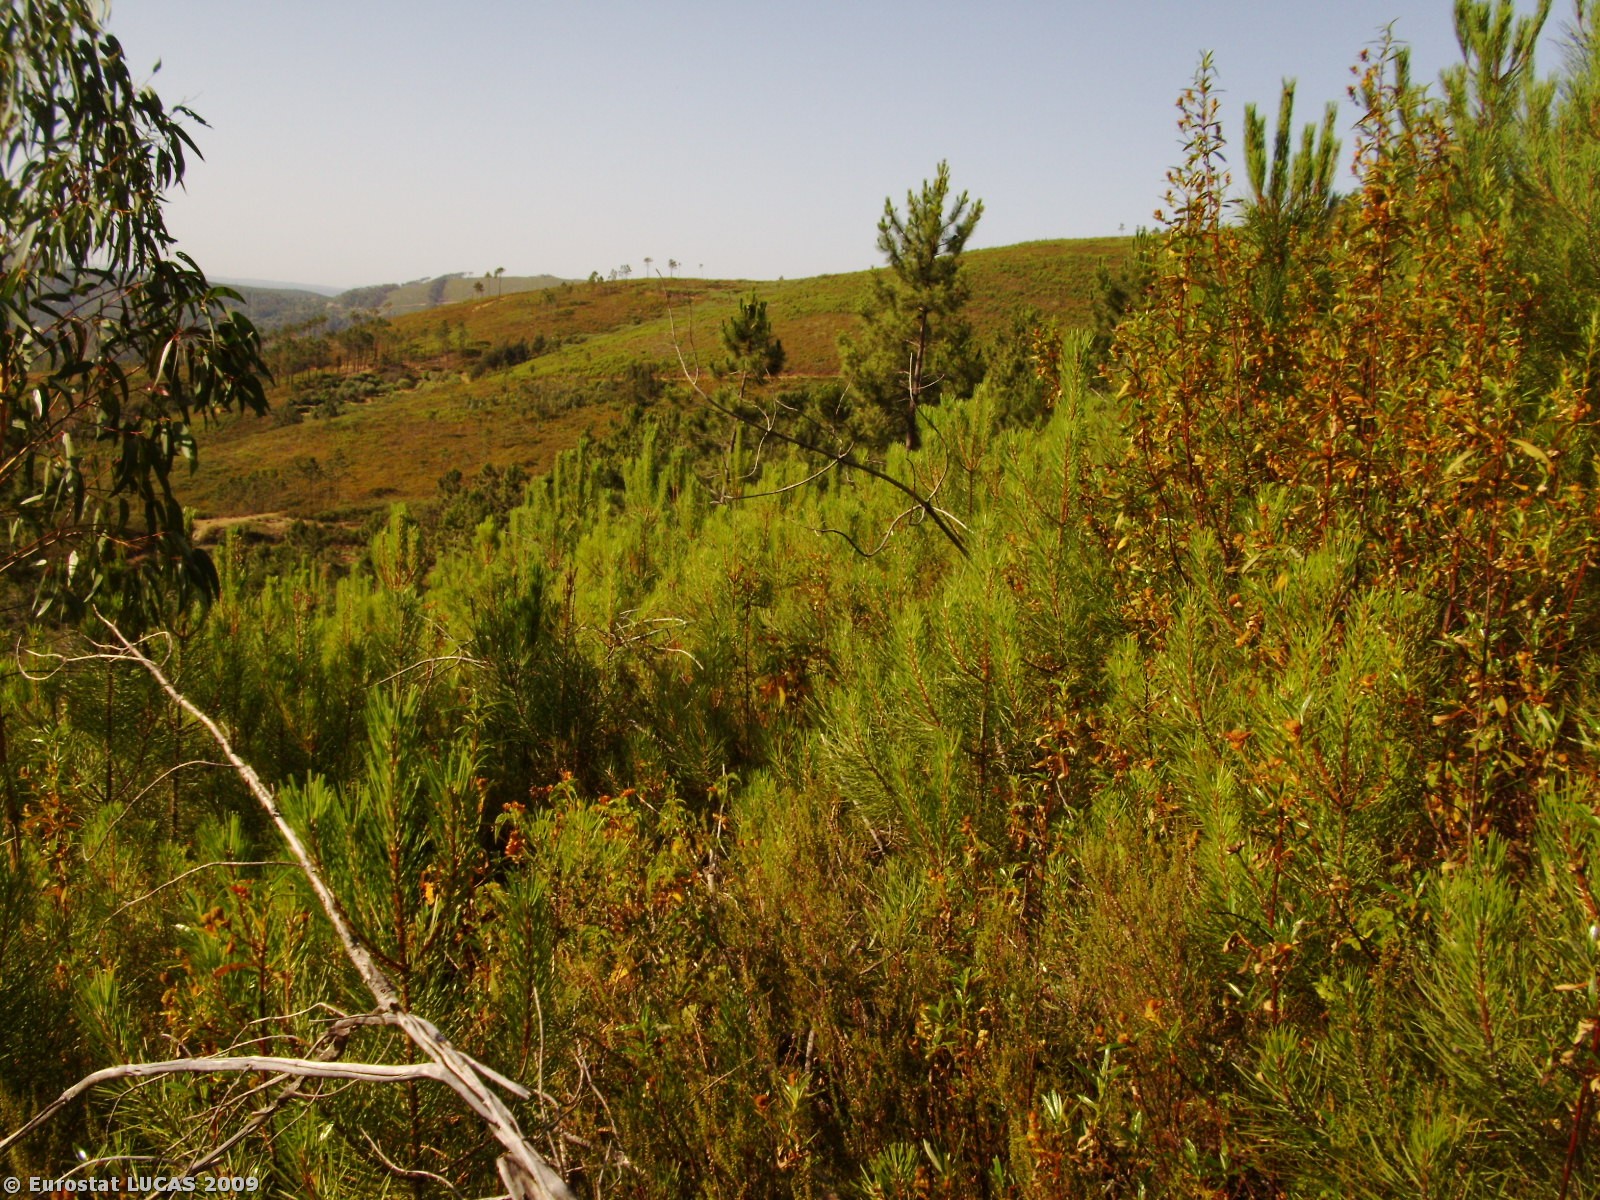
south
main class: Woodland
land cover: Coniferous woodland
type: coniferous forest of the mediterranean region
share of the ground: > 75 %
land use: Forestry
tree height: > 5 m
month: June
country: PT
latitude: 40.0157
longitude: -7.6690
